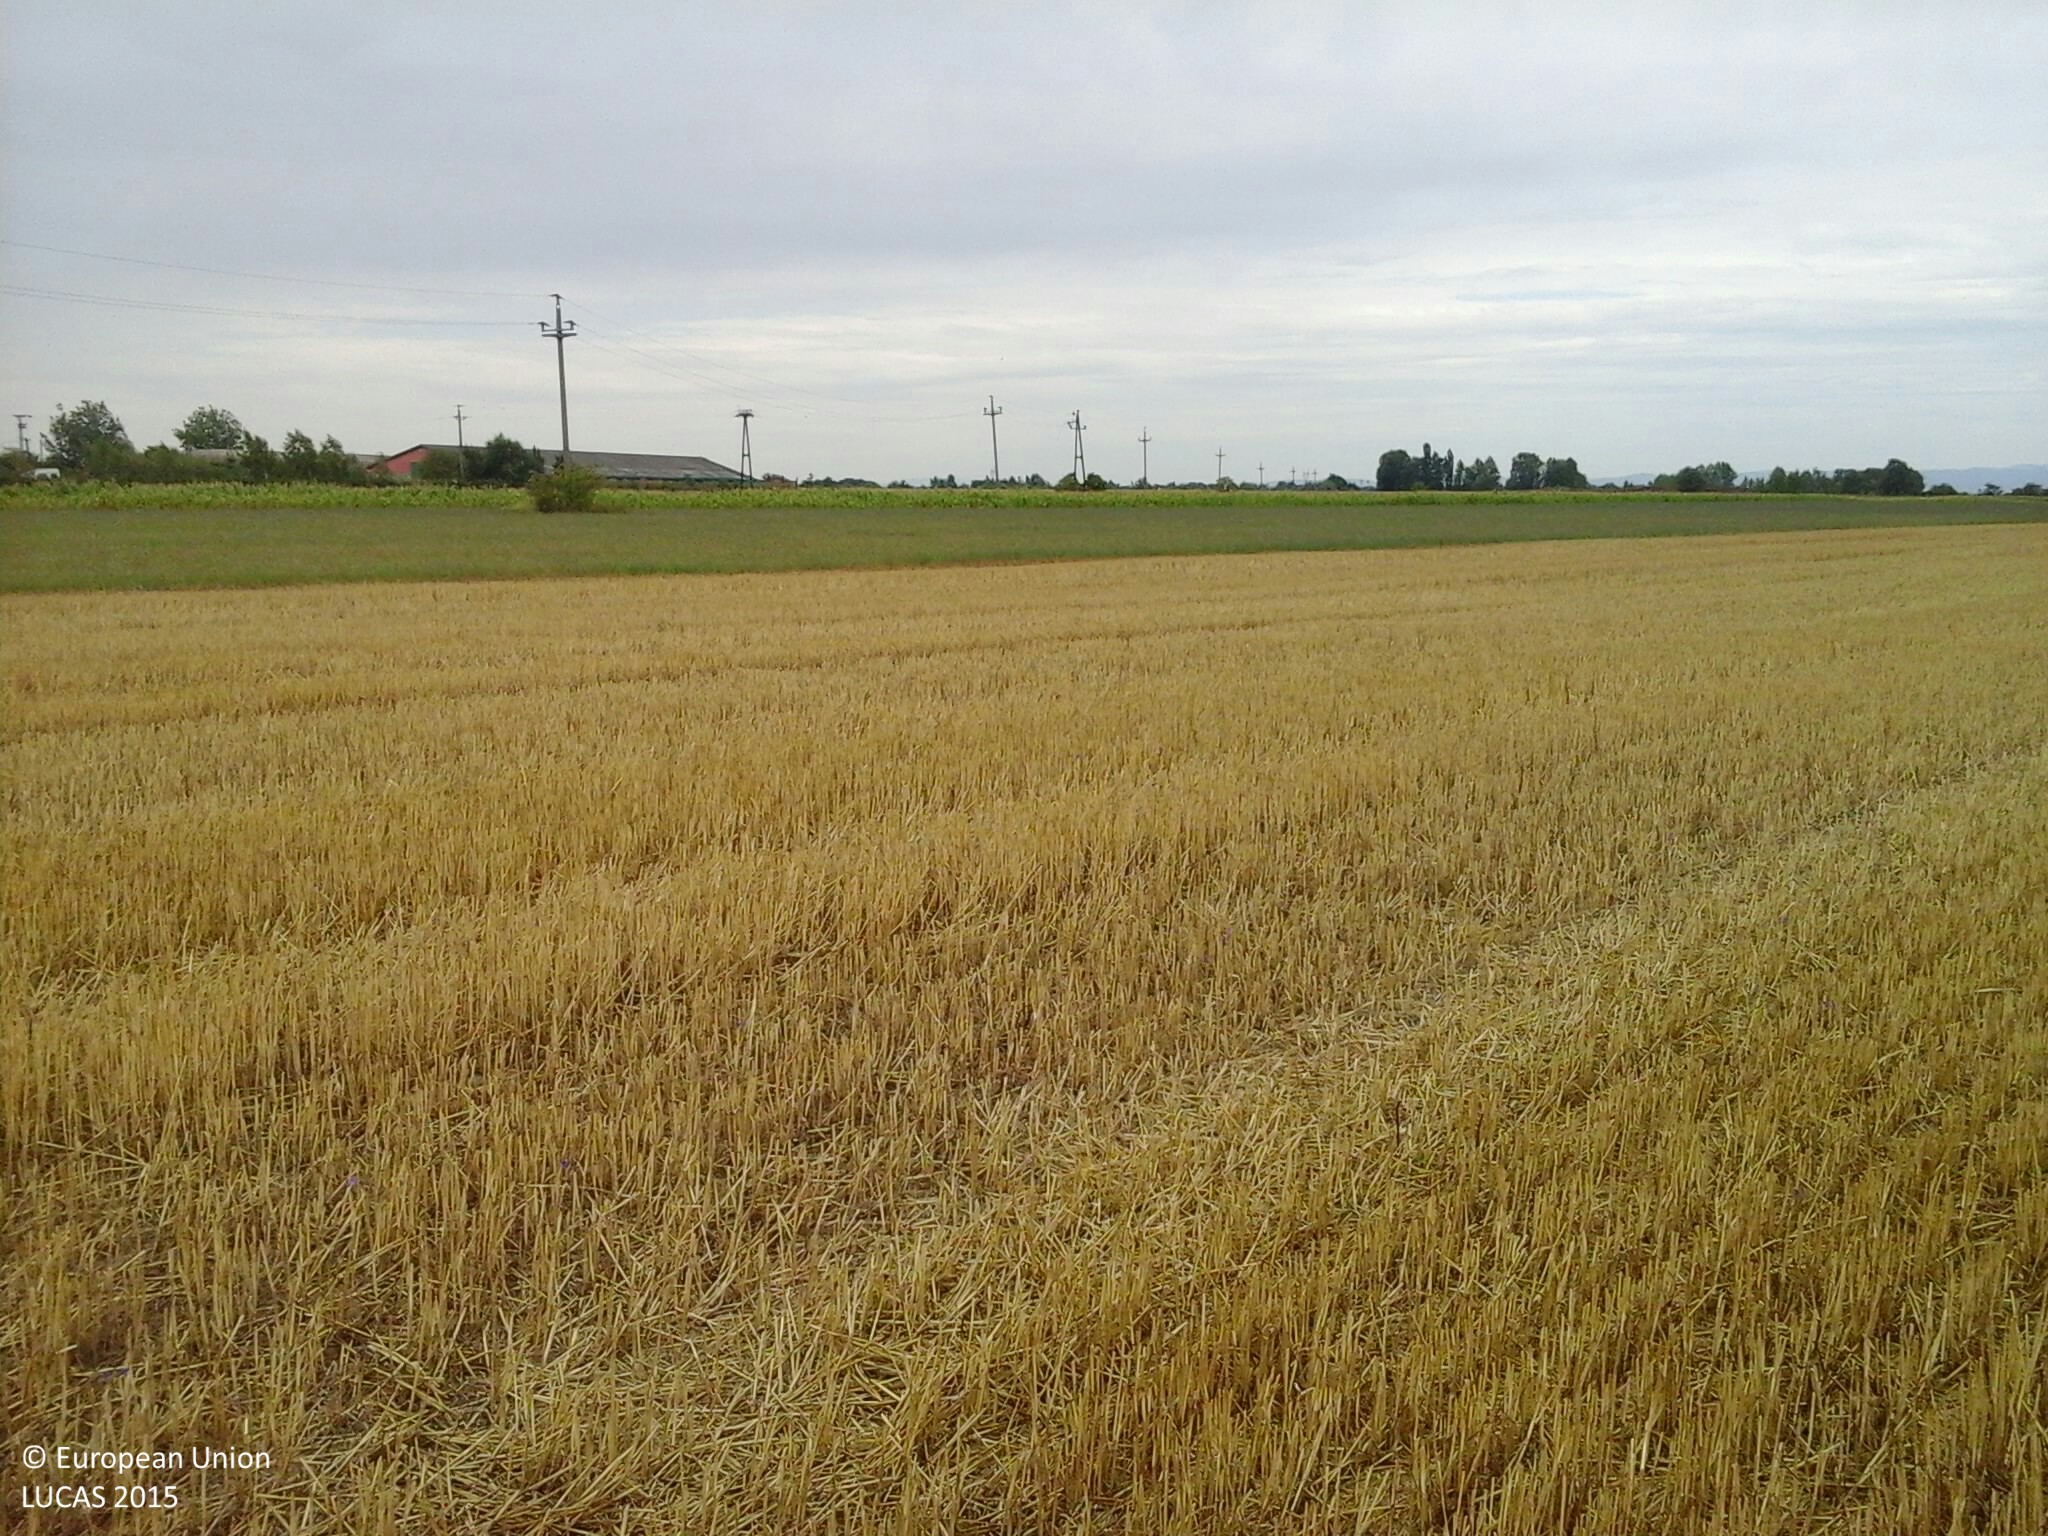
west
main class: Cropland
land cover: Common wheat
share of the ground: > 75 %
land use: Agriculture (excluding fallow land and kitchen gardens)
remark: Harvested field
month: July
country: HU
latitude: 47.8545
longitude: 20.9841
